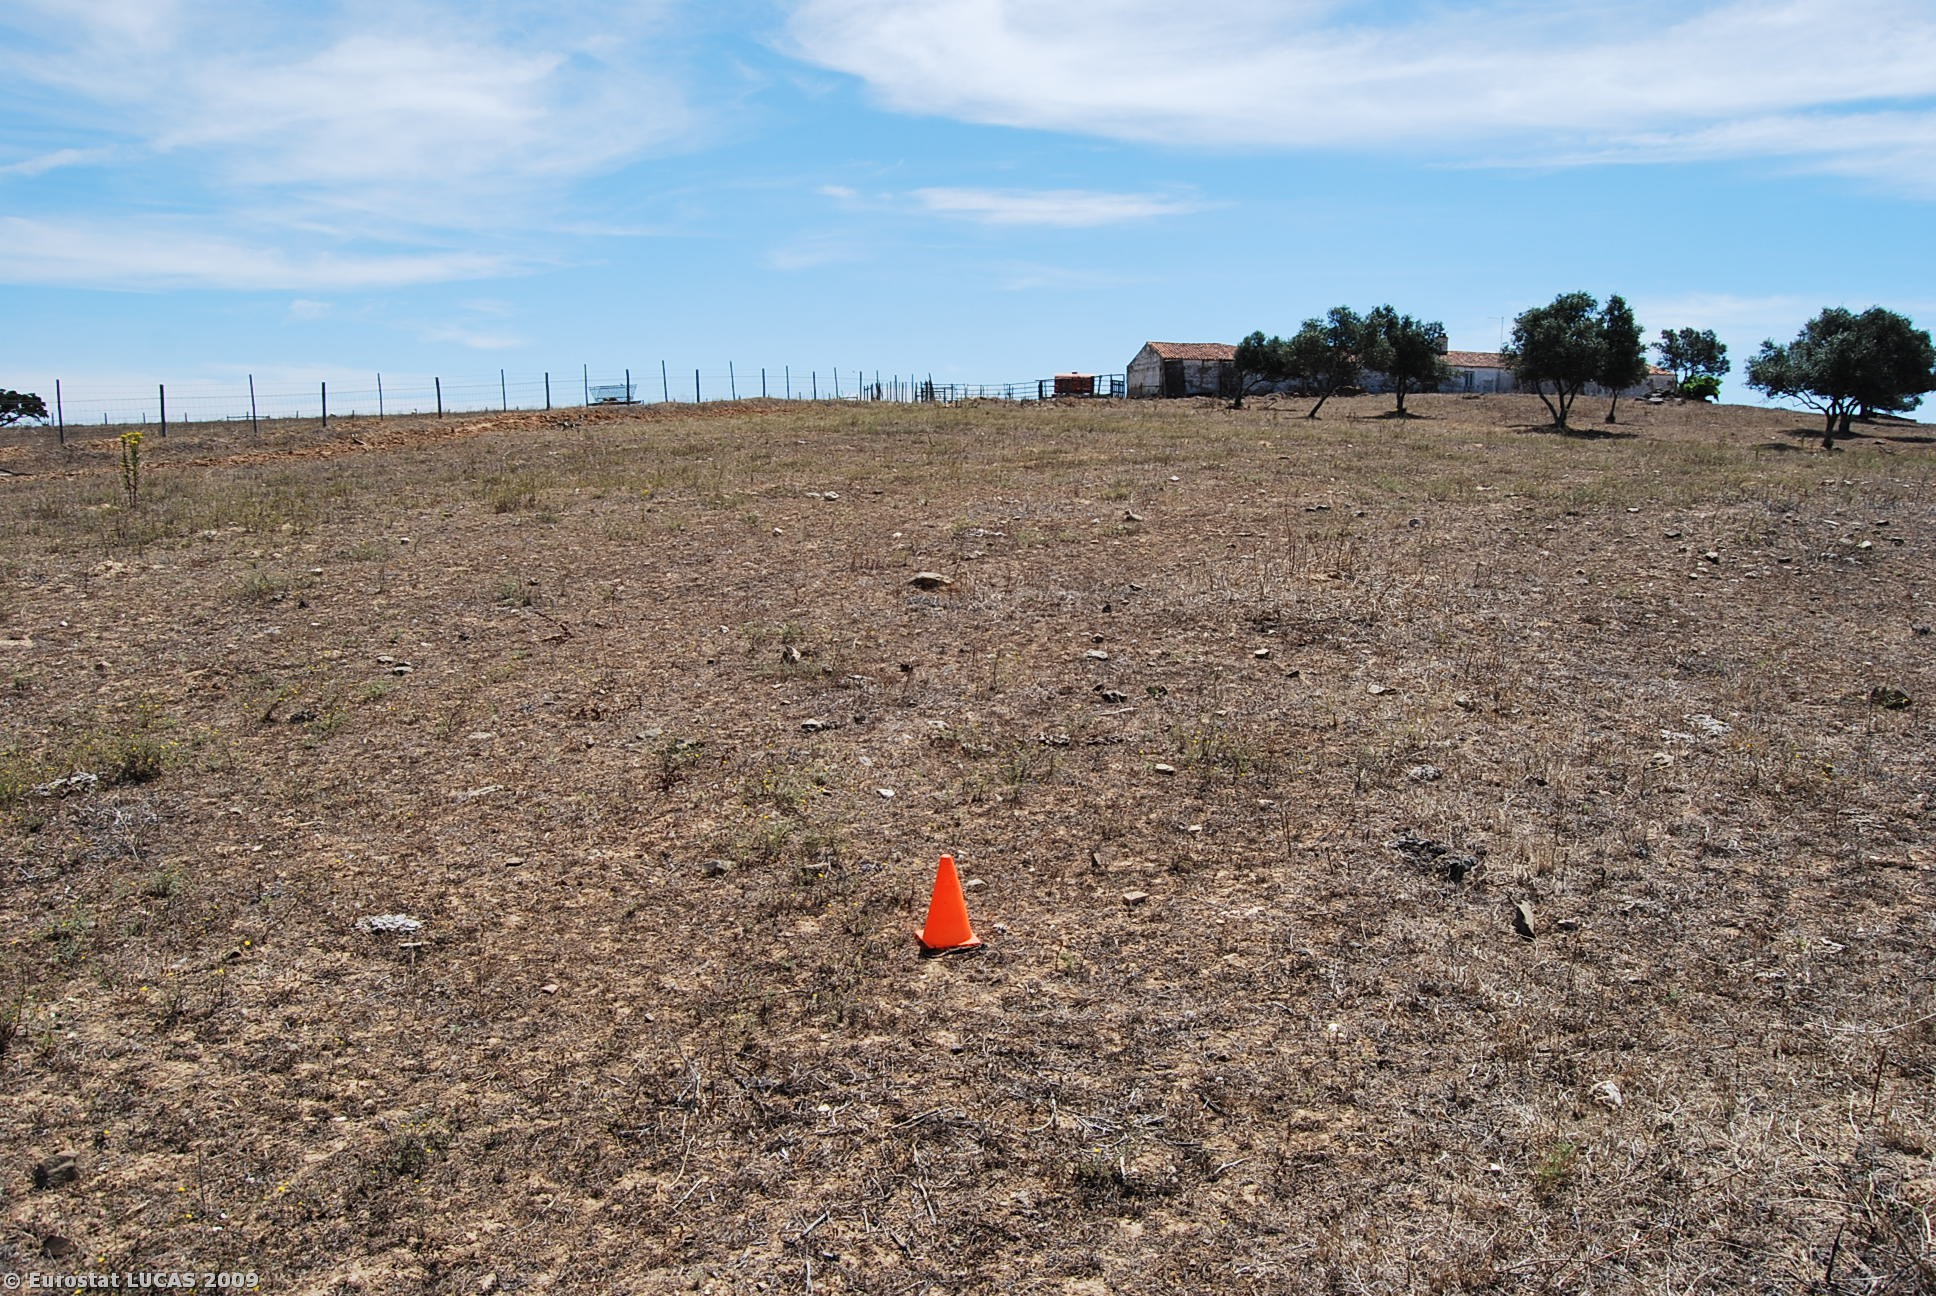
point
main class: Grassland
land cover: Grassland without tree/shrub cover
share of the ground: > 75 %
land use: Agriculture (excluding fallow land and kitchen gardens)
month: July
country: PT
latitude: 37.6829
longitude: -8.2756
